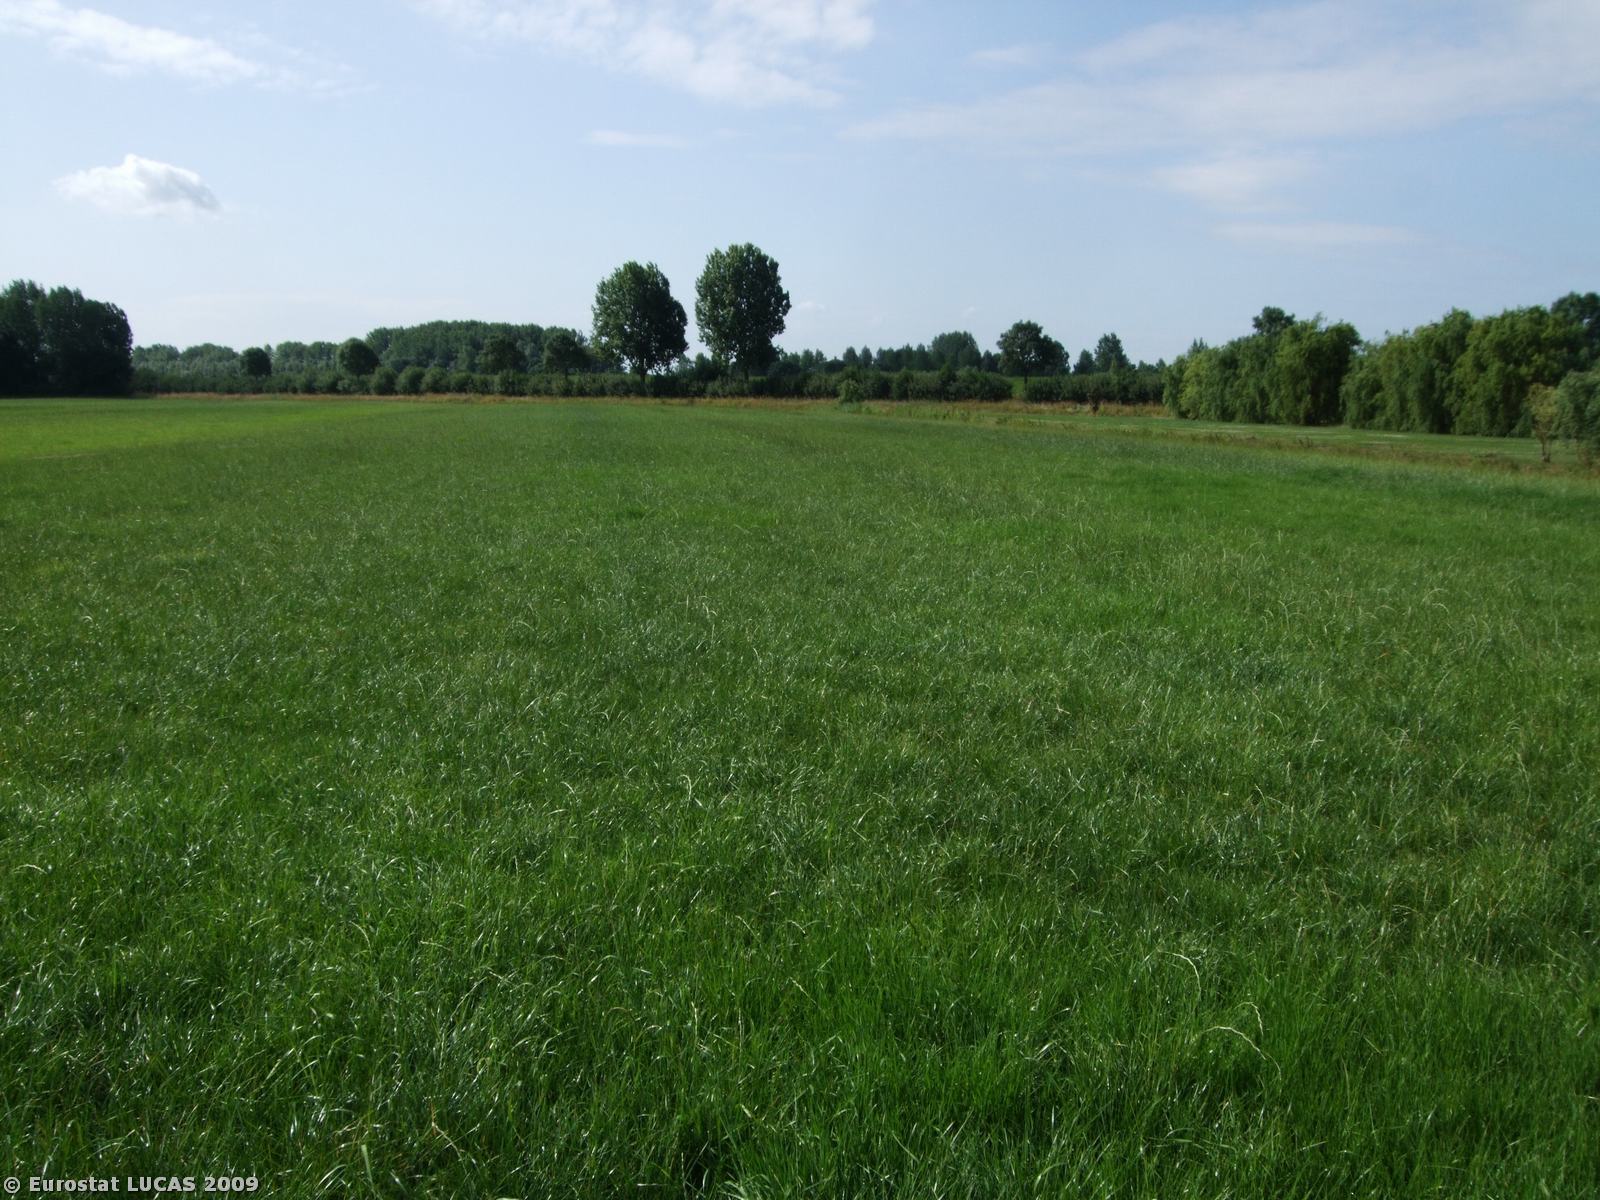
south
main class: Grassland
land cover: Grassland without tree/shrub cover
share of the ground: > 75 %
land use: Agriculture (excluding fallow land and kitchen gardens)
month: July
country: NL
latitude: 51.9458
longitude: 5.3863
